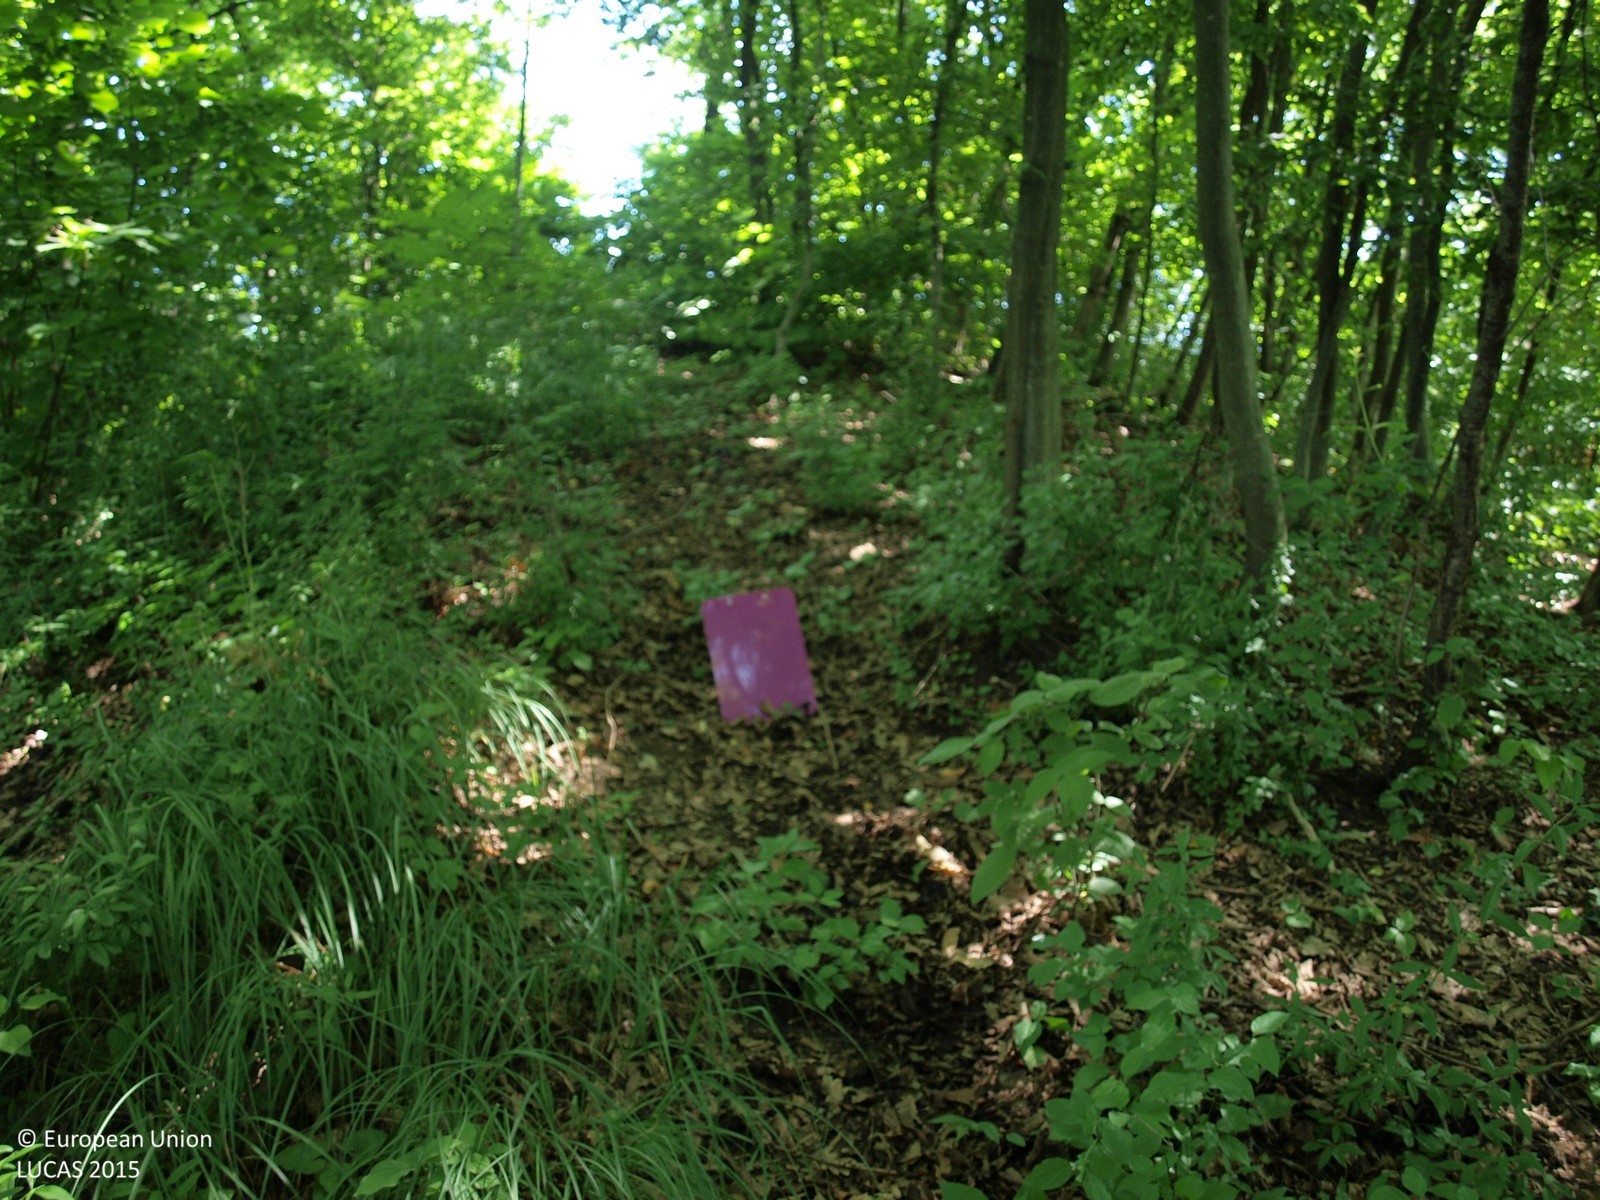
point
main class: Woodland
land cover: Broadleaved woodland
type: mesophytic deciduous forest
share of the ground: > 75 %
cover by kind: broadleaved forest trees 100 %
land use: Forestry
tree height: > 5 m
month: June
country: HR
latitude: 46.1612
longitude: 15.7352
